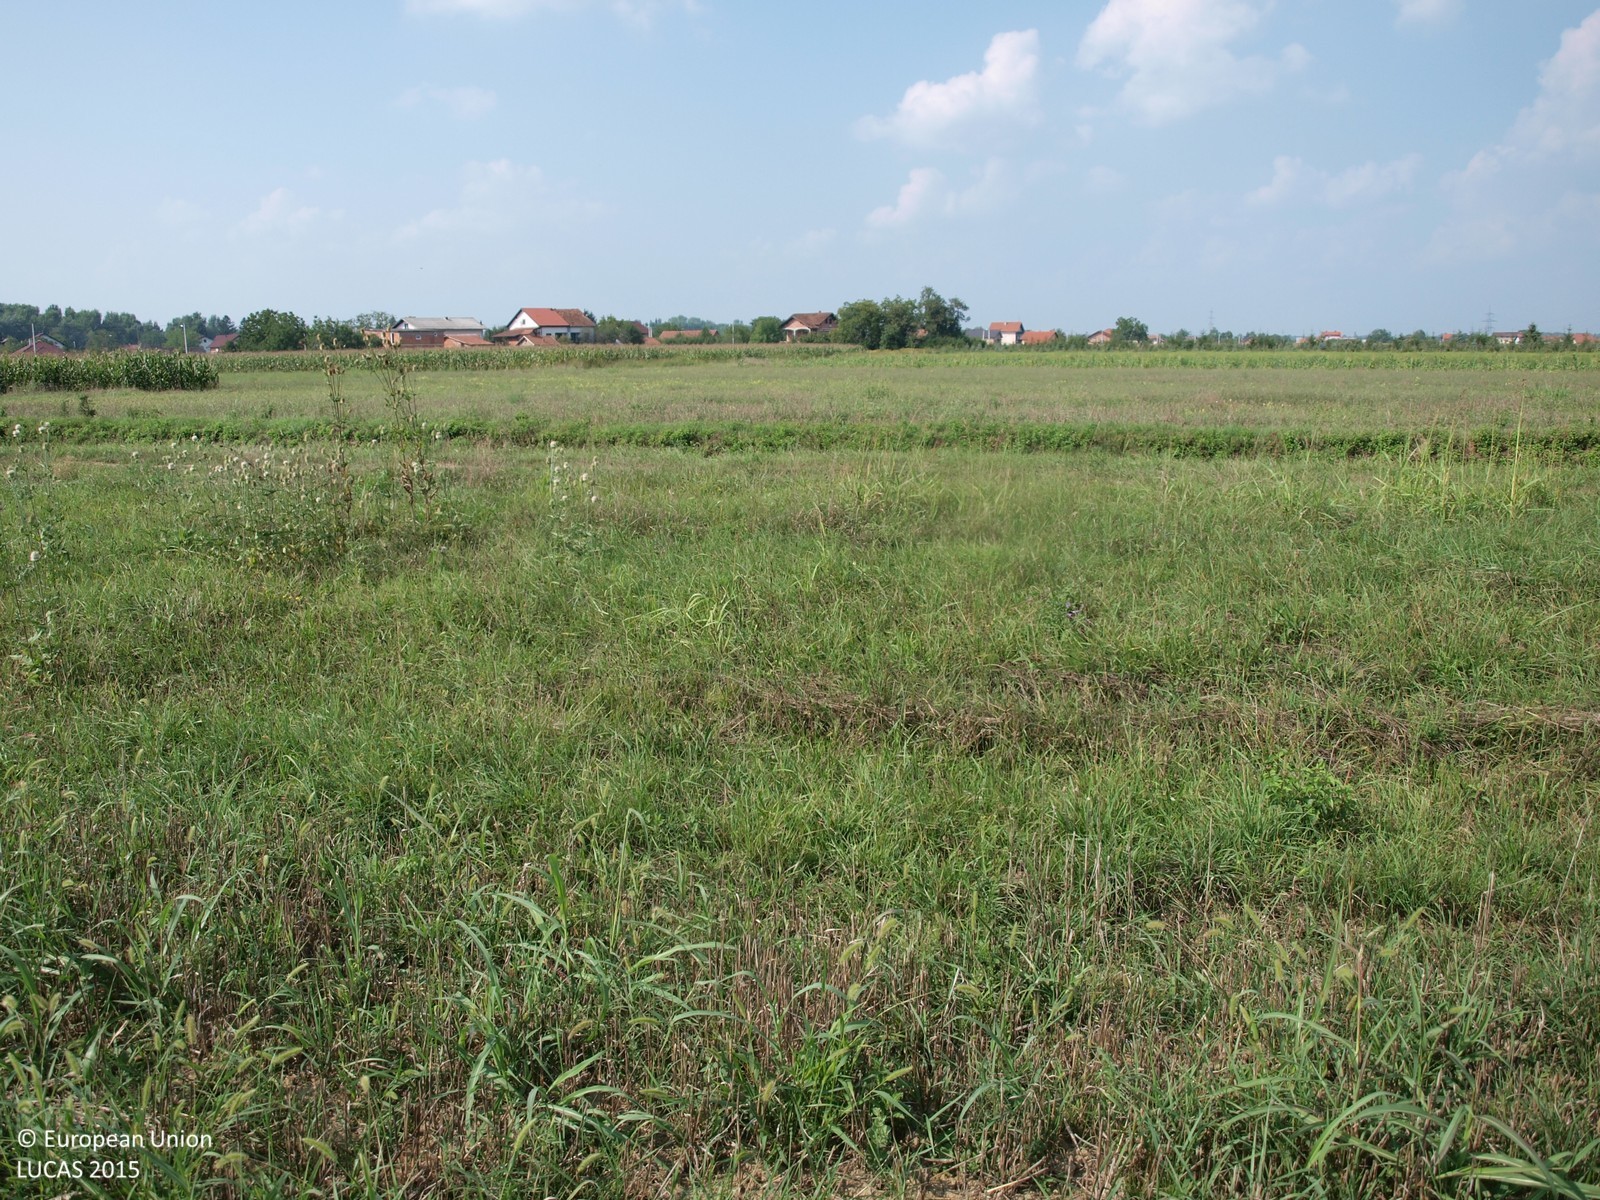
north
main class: Cropland
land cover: Common wheat
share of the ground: > 75 %
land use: Agriculture (excluding fallow land and kitchen gardens)
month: August
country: HR
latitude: 45.7359
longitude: 16.2312
